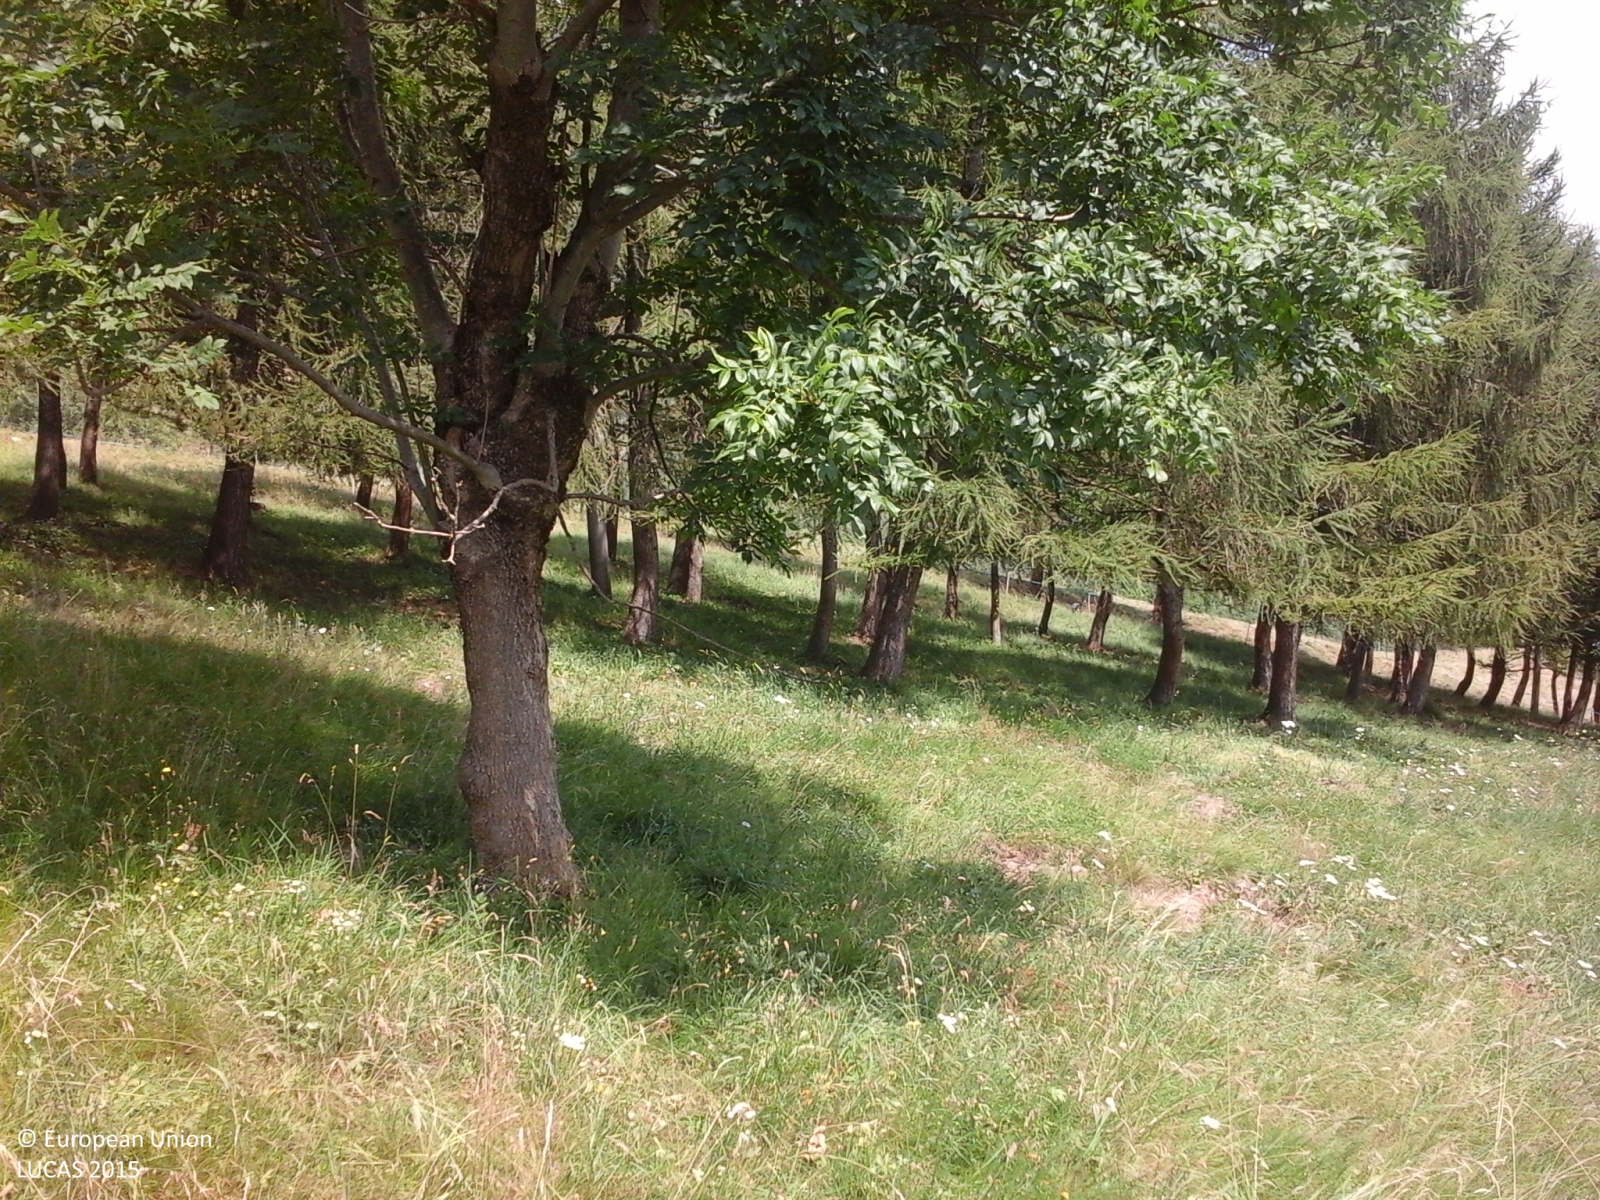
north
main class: Woodland
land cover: Broadleaved woodland
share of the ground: 25 - 50 %
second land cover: Grassland without tree/shrub cover
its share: > 75 %
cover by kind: herbaceous plants 60 %, broadleaved forest trees 40 %
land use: Forestry
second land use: Agriculture (excluding fallow land and kitchen gardens)
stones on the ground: 25 - 50 %
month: July
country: IT
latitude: 45.4425
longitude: 7.6641
